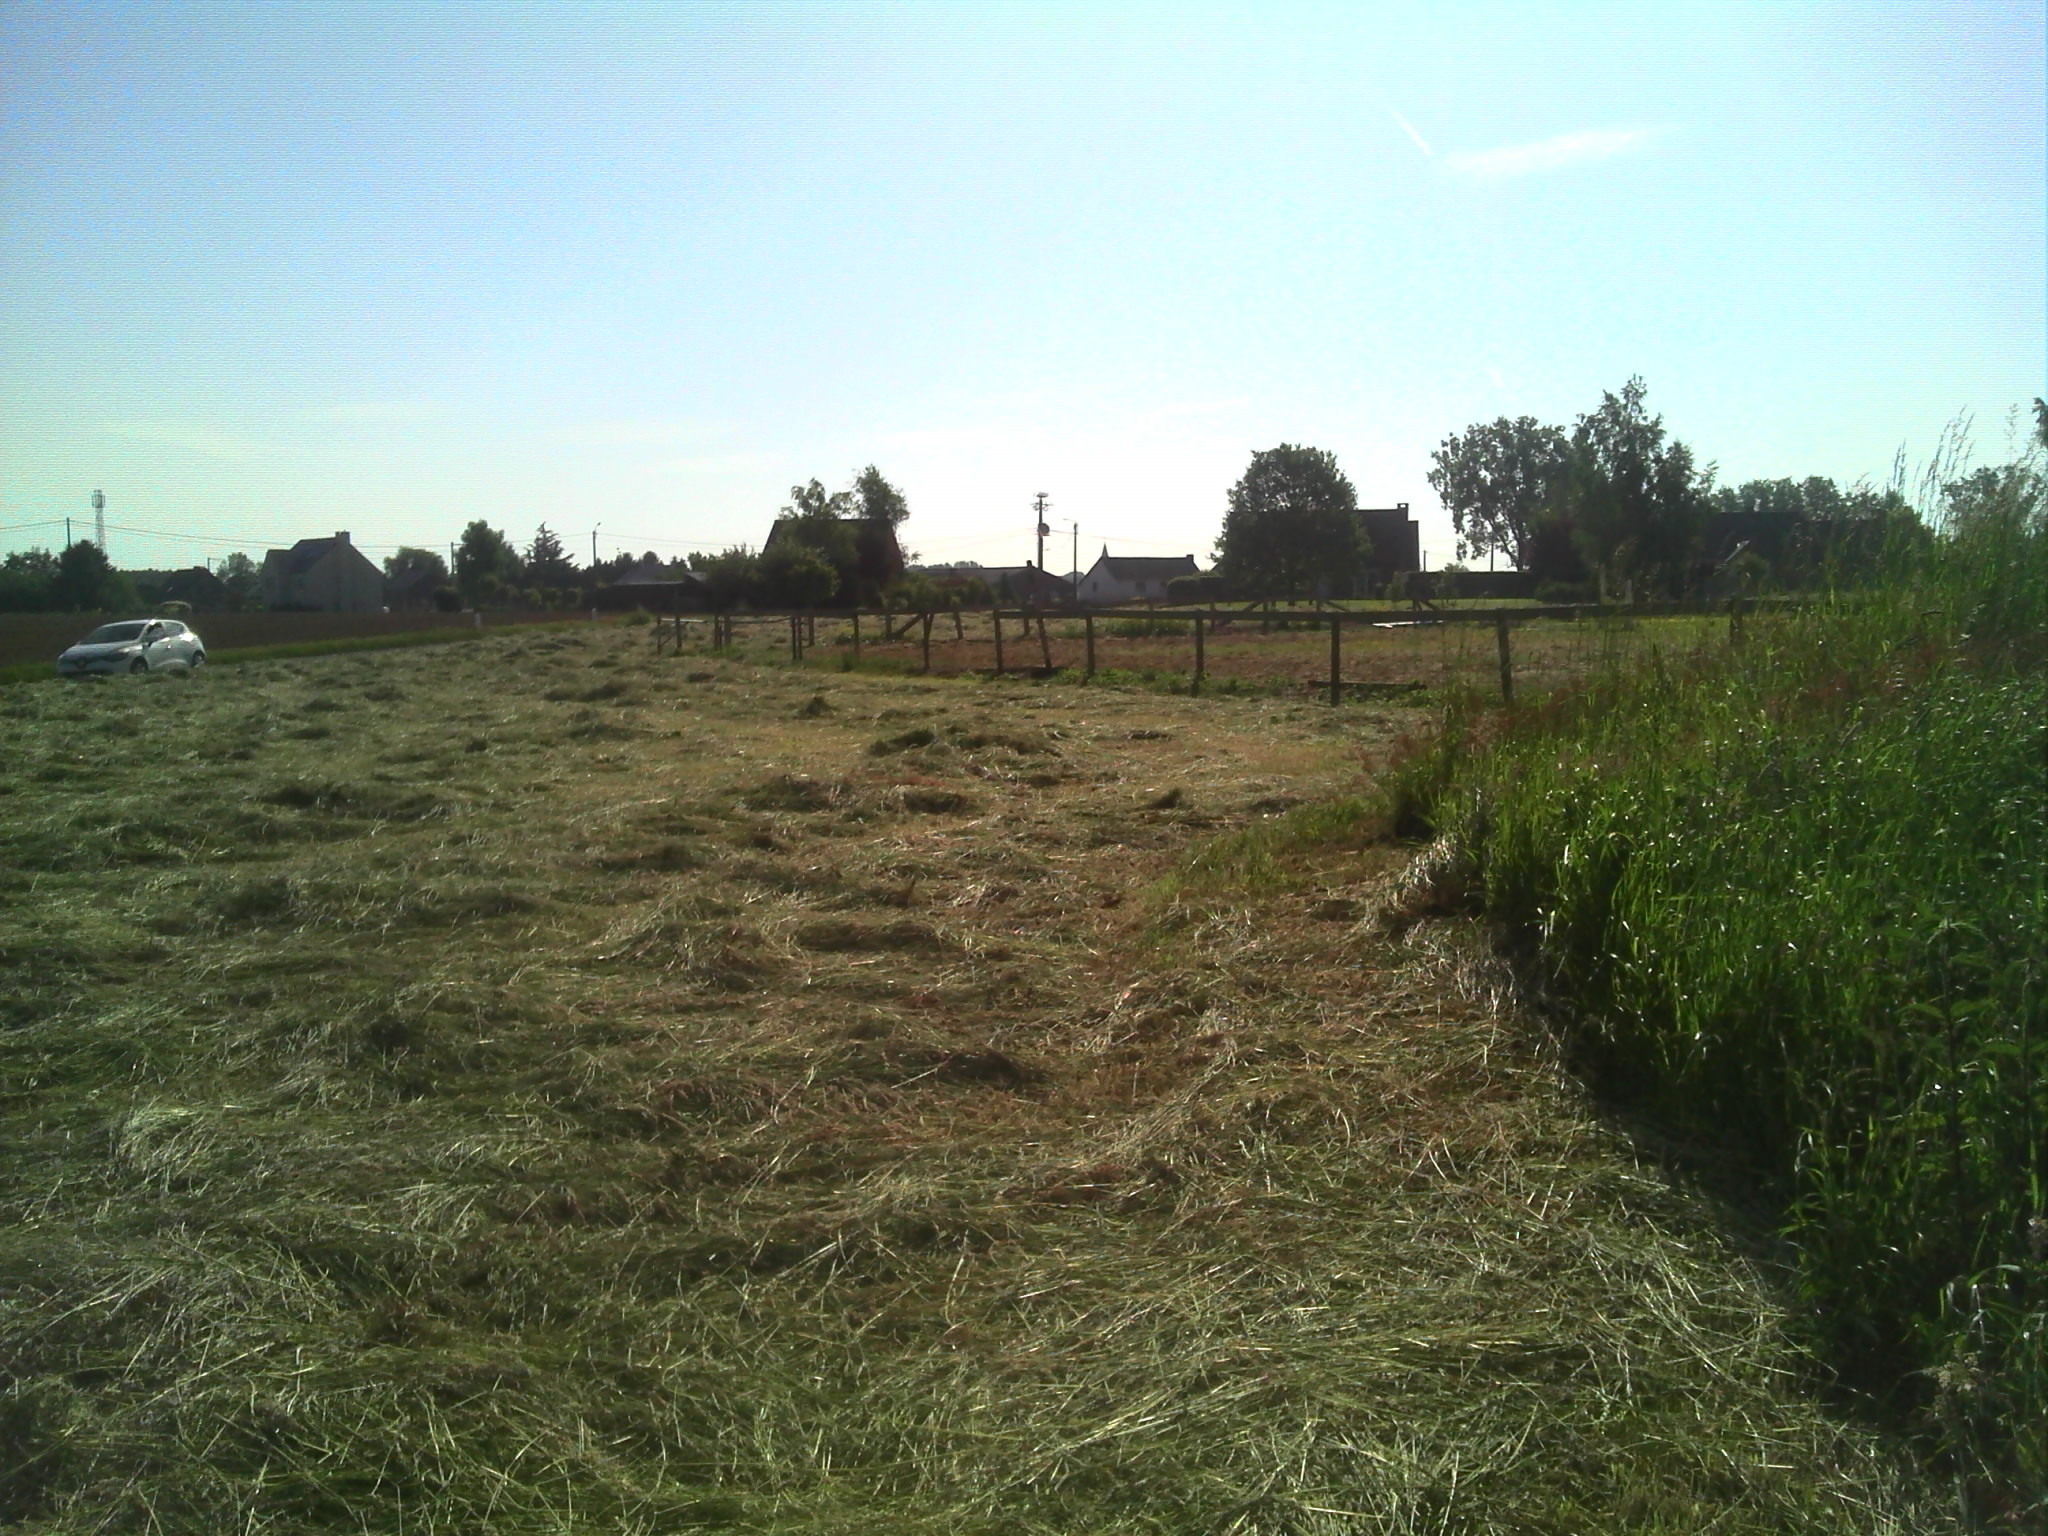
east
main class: Grassland
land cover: Grassland without tree/shrub cover
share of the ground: > 75 %
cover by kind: herbaceous plants 100 %
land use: Agriculture (excluding fallow land and kitchen gardens)
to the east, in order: Grassland without tree/shrub cover; Fences; Sand; Fences; Grassland without tree/shrub cover; Artificial constructions in urban areas; Grassland without tree/shrub cover
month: June
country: BE
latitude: 50.5516
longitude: 4.7886
